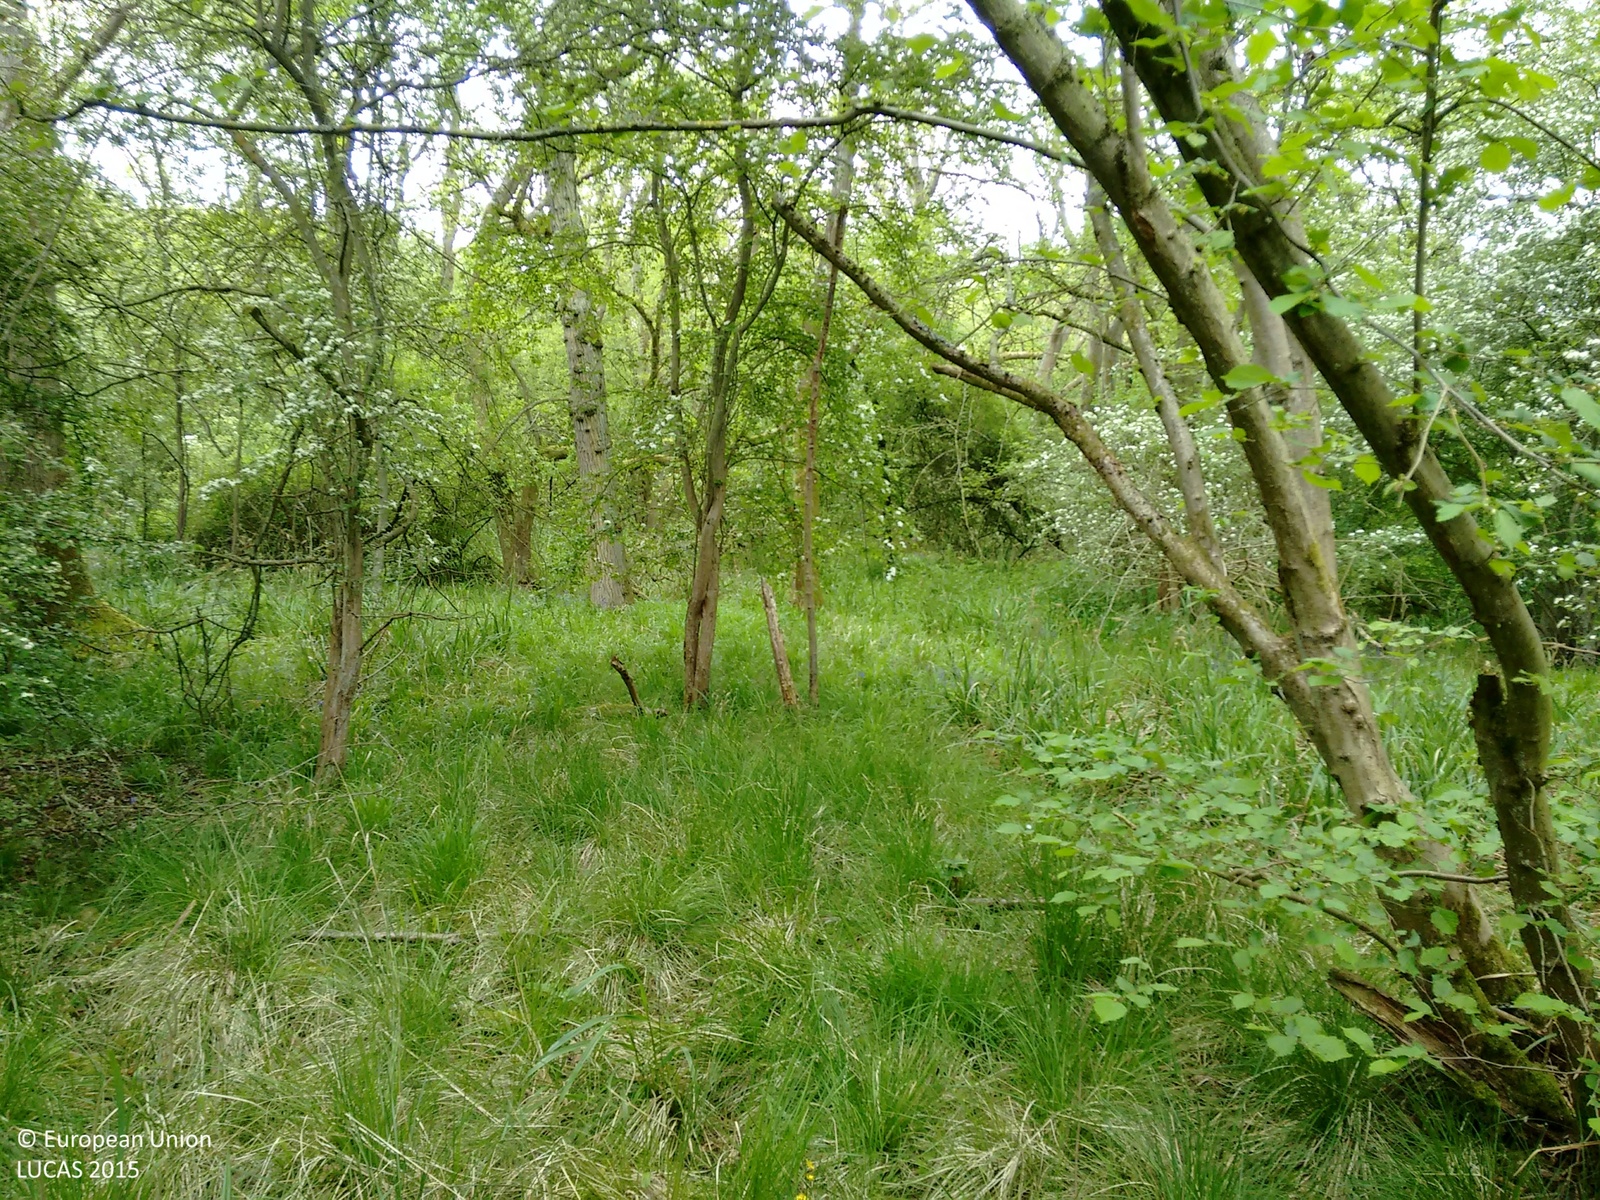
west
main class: Woodland
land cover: Broadleaved woodland
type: mesophytic deciduous forest
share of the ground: > 75 %
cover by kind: broadleaved forest trees 100 %
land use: Community services
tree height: > 5 m
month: May
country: GB
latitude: 52.0660
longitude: -0.5859
